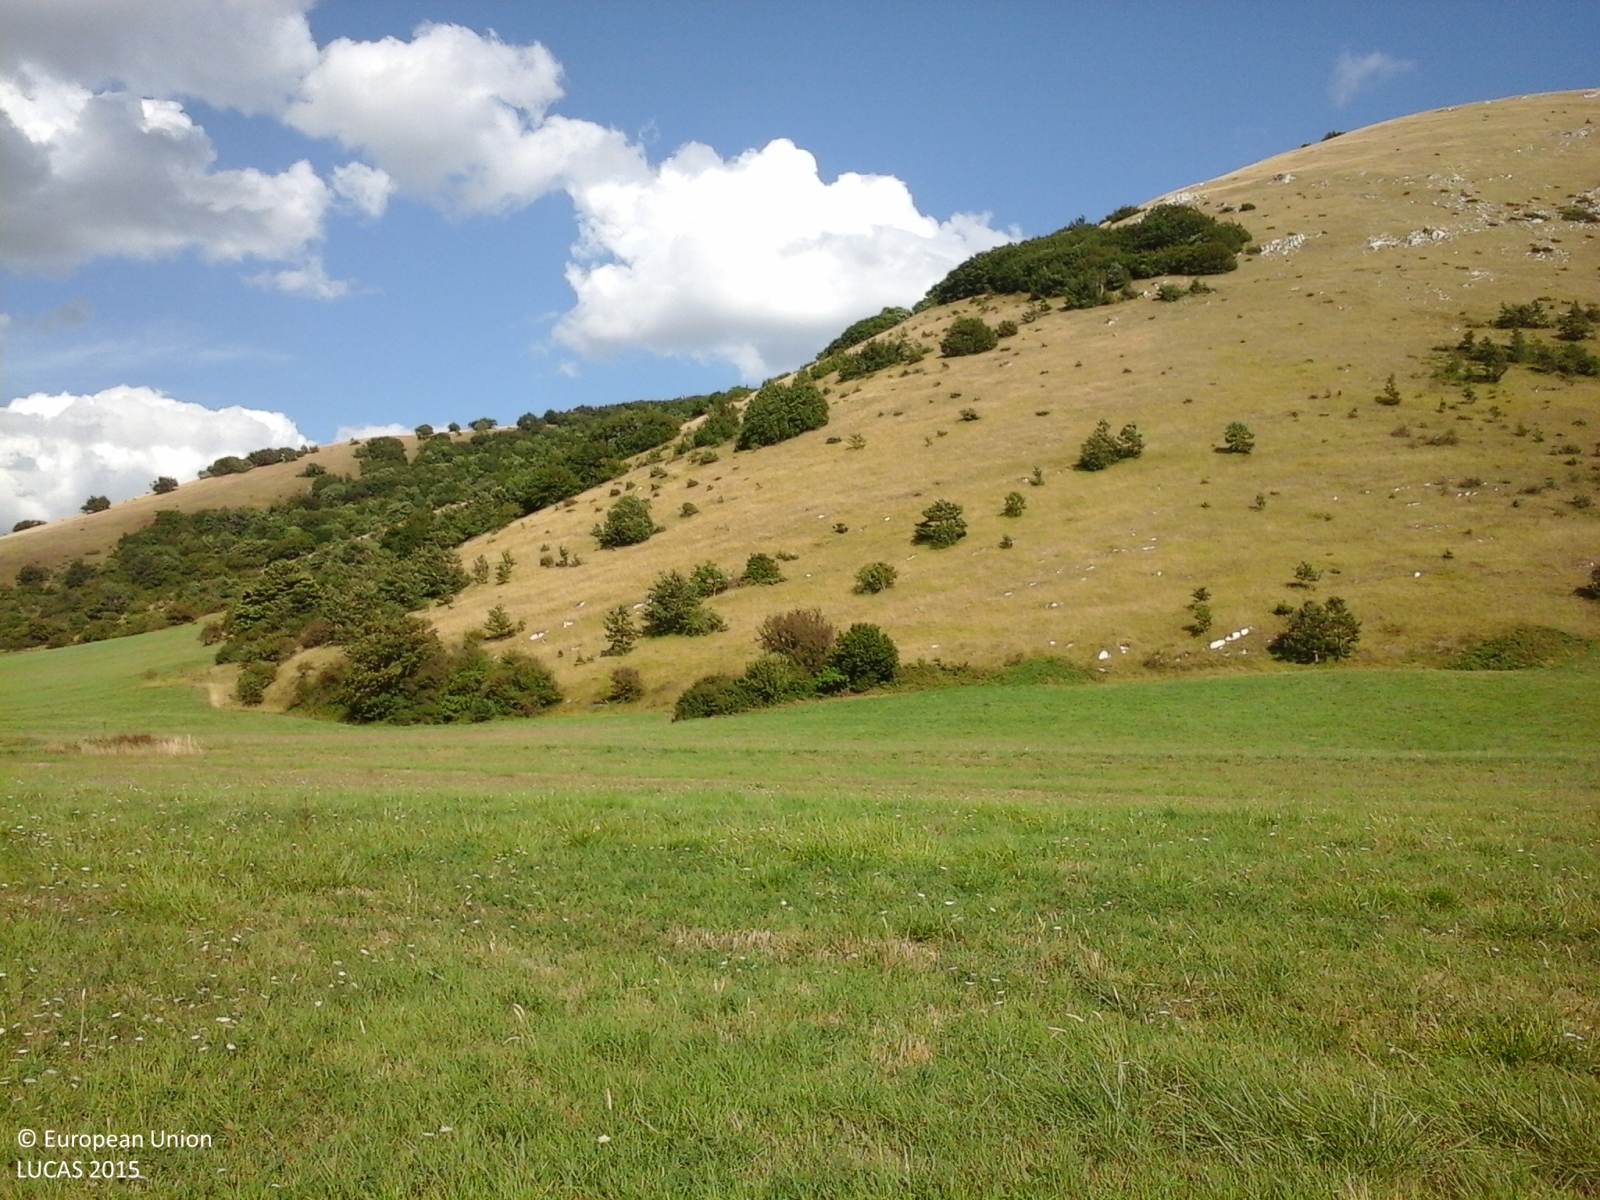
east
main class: Cropland
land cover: Temporary grasslands
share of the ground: > 75 %
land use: Agriculture (excluding fallow land and kitchen gardens)
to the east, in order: Temporary grasslands; Broadleaved woodland
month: August
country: IT
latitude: 43.1162
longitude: 12.9781
